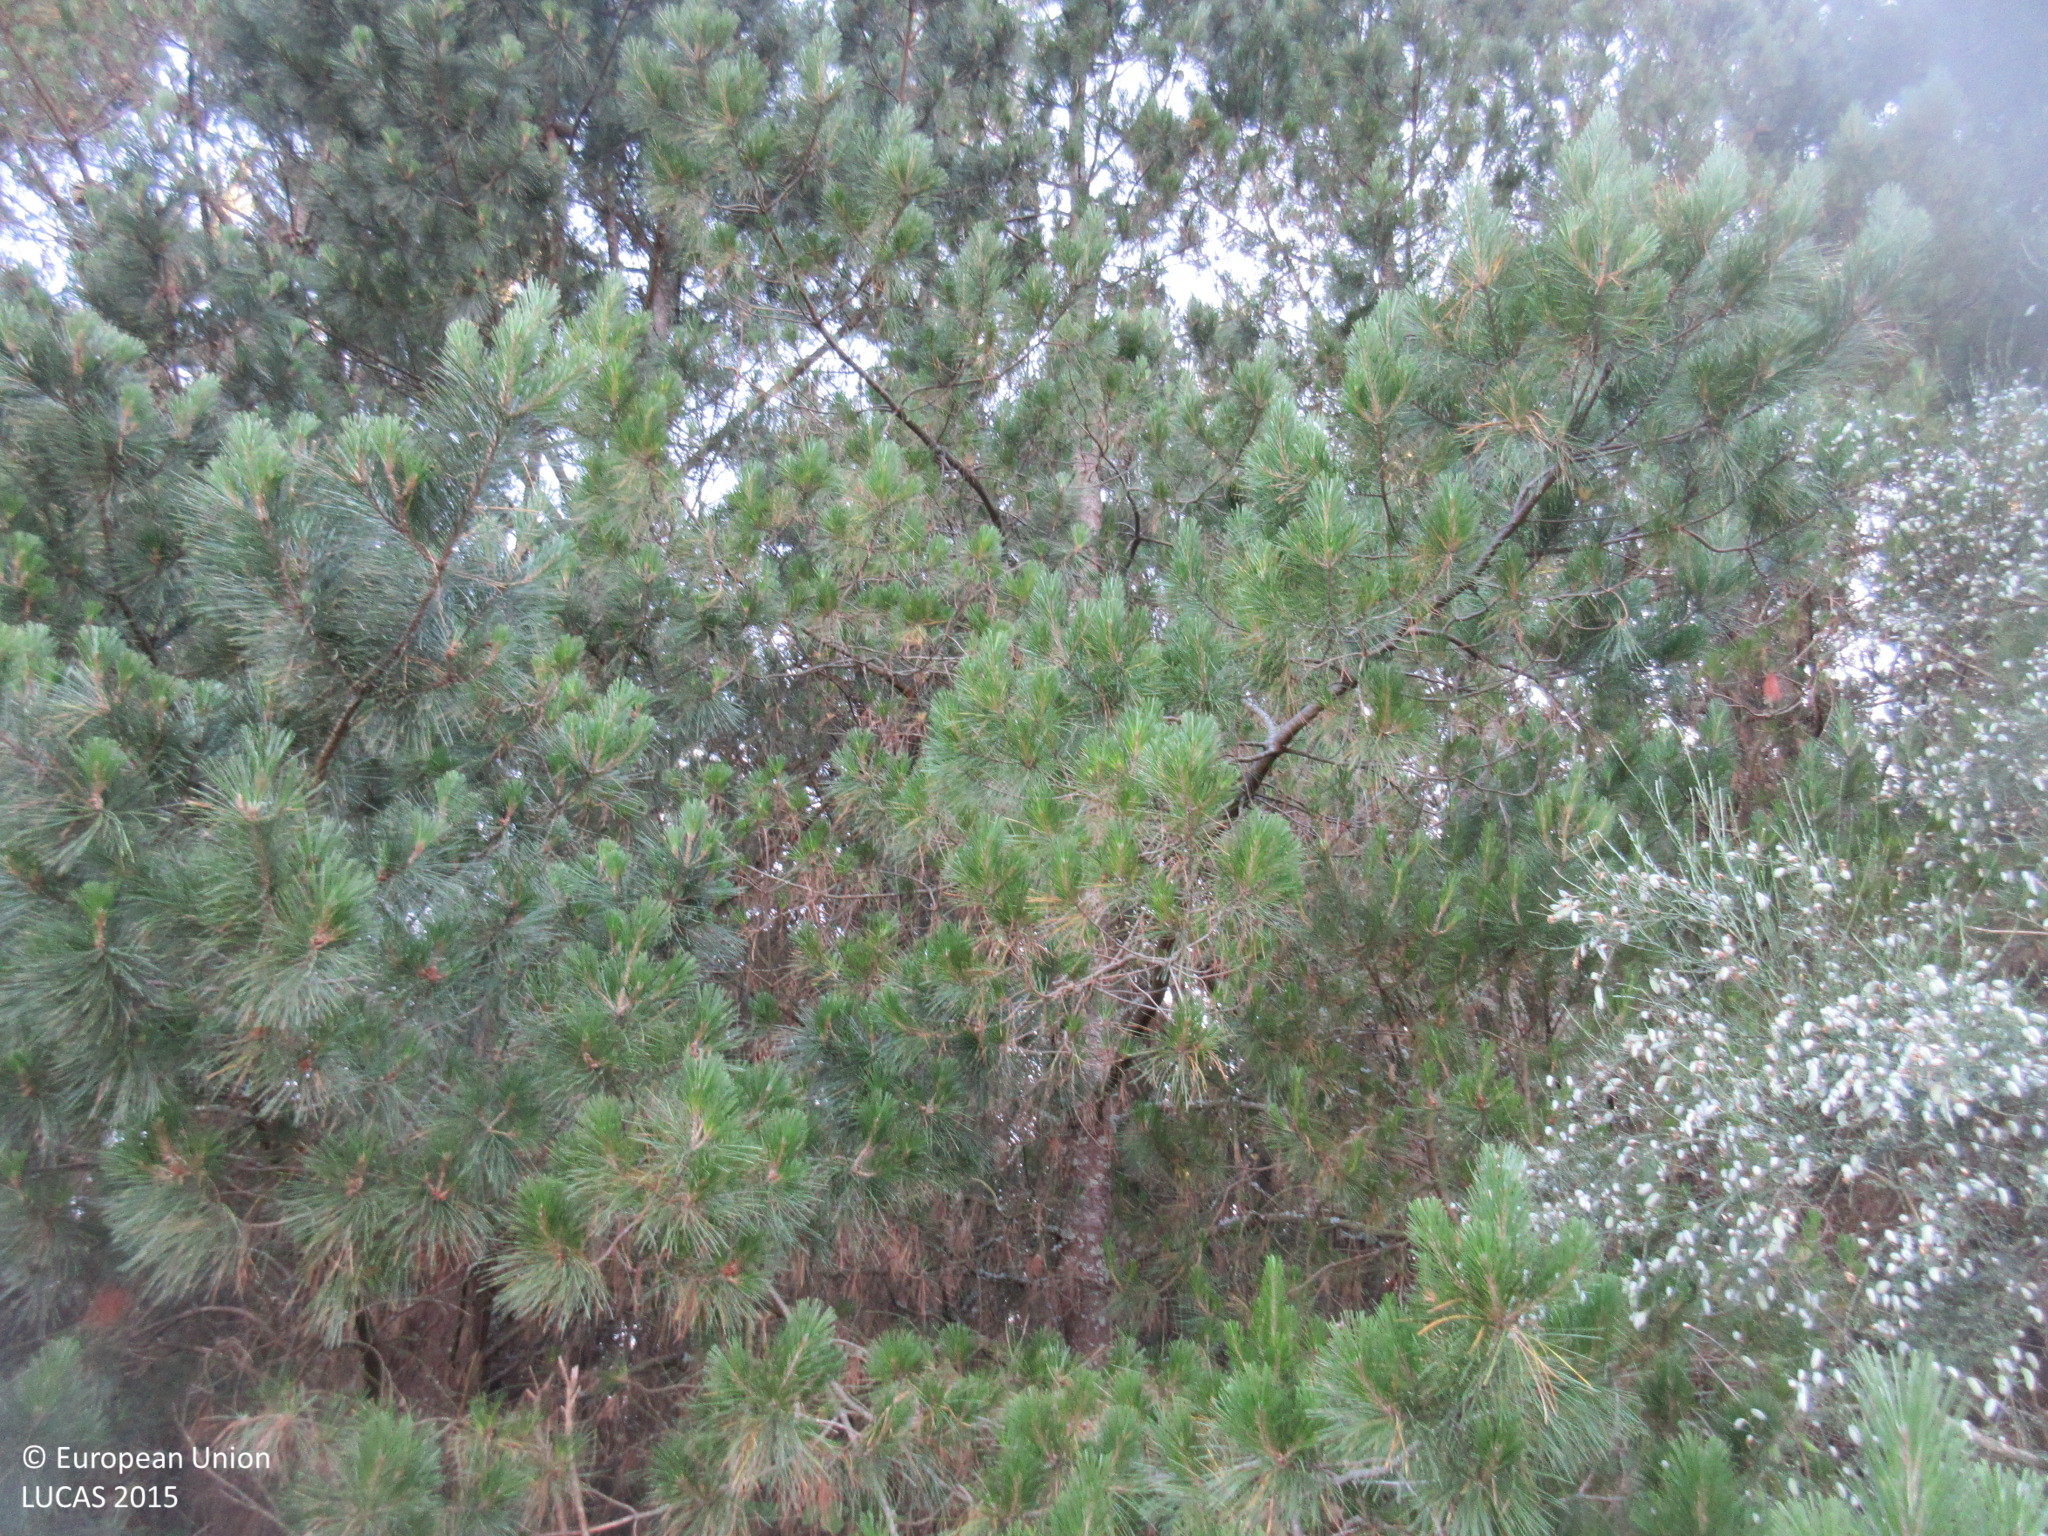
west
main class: Woodland
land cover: Pine dominated coniferous woodland
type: hemiboreal forest and nemoral coniferous forest and mixed broadleaved-coniferous forest
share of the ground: > 75 %
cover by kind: coniferous forest trees 100 %
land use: Forestry
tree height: > 5 m
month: June
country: ES
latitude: 43.0431
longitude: -7.0152
